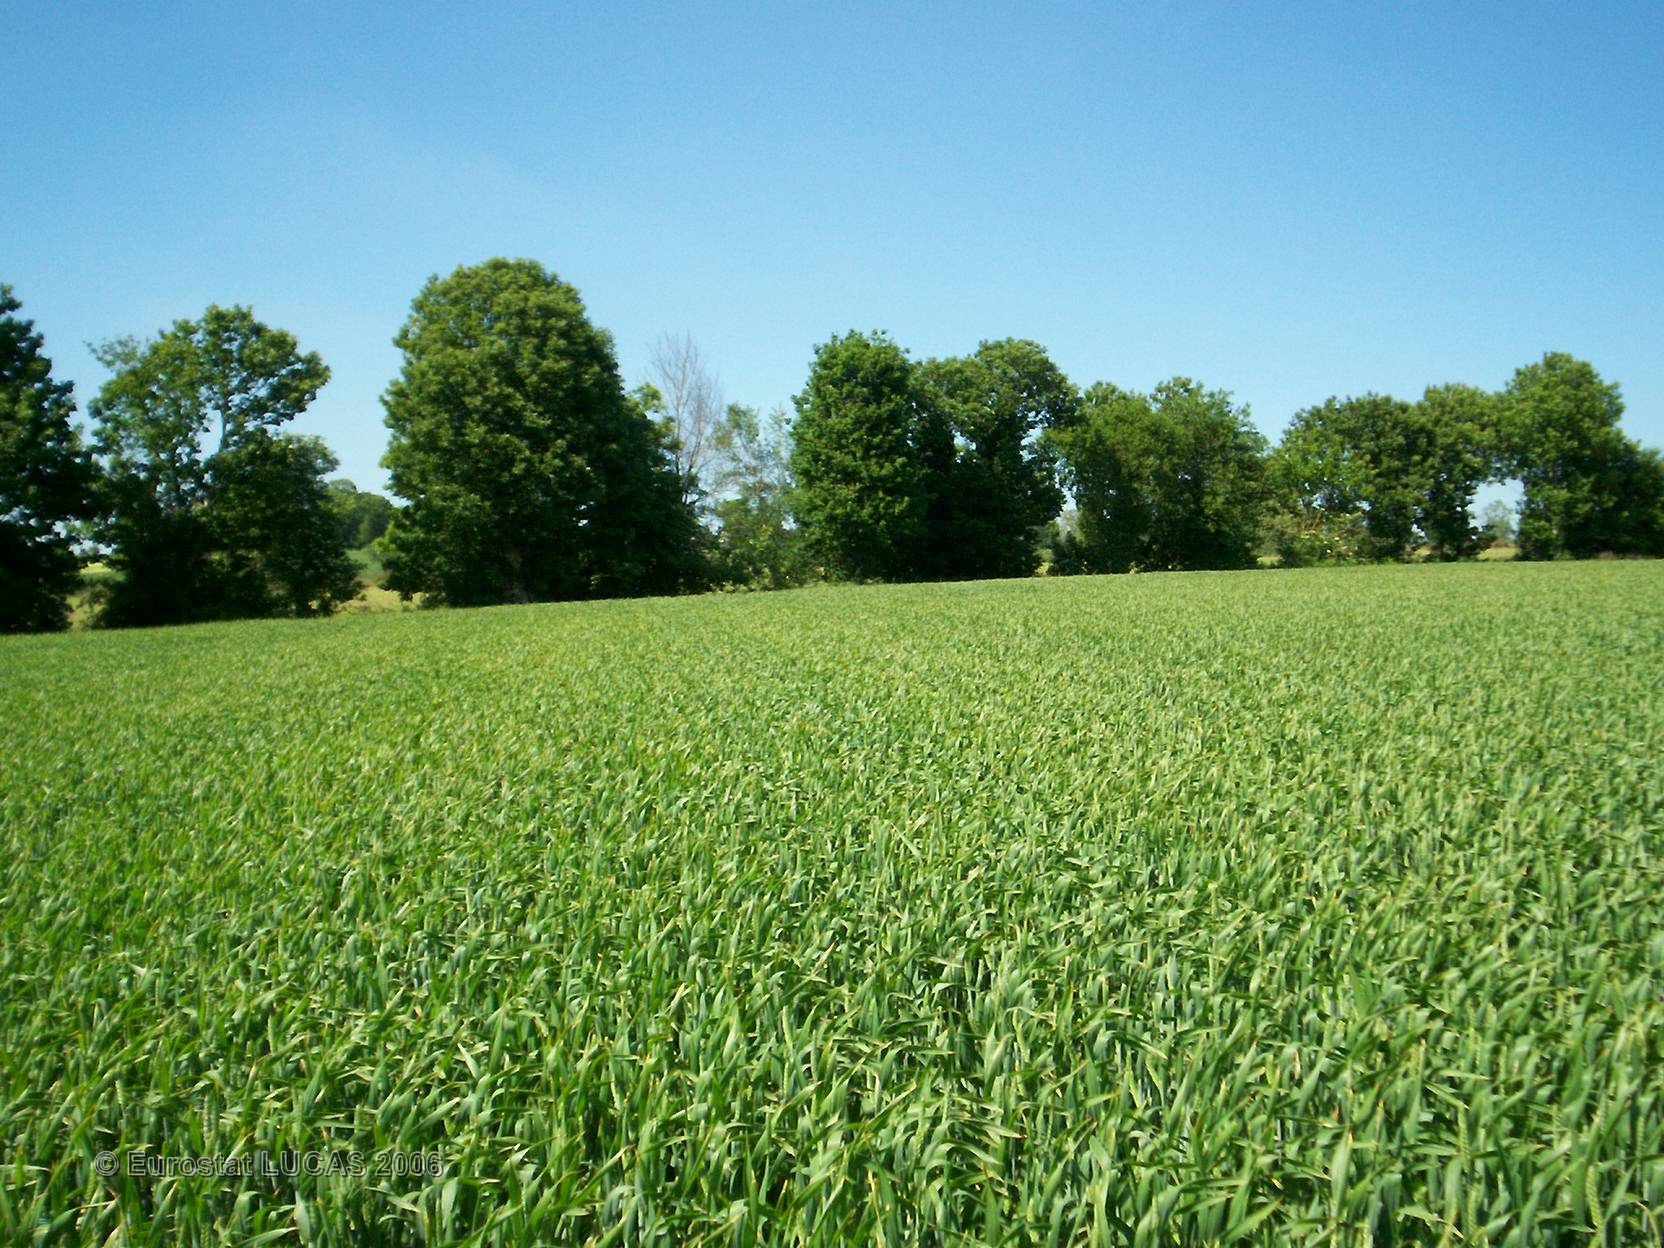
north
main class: Cropland
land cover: Common wheat
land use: Agriculture (excluding fallow land and kitchen gardens)
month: June
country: FR
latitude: 48.4180
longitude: -1.6830
